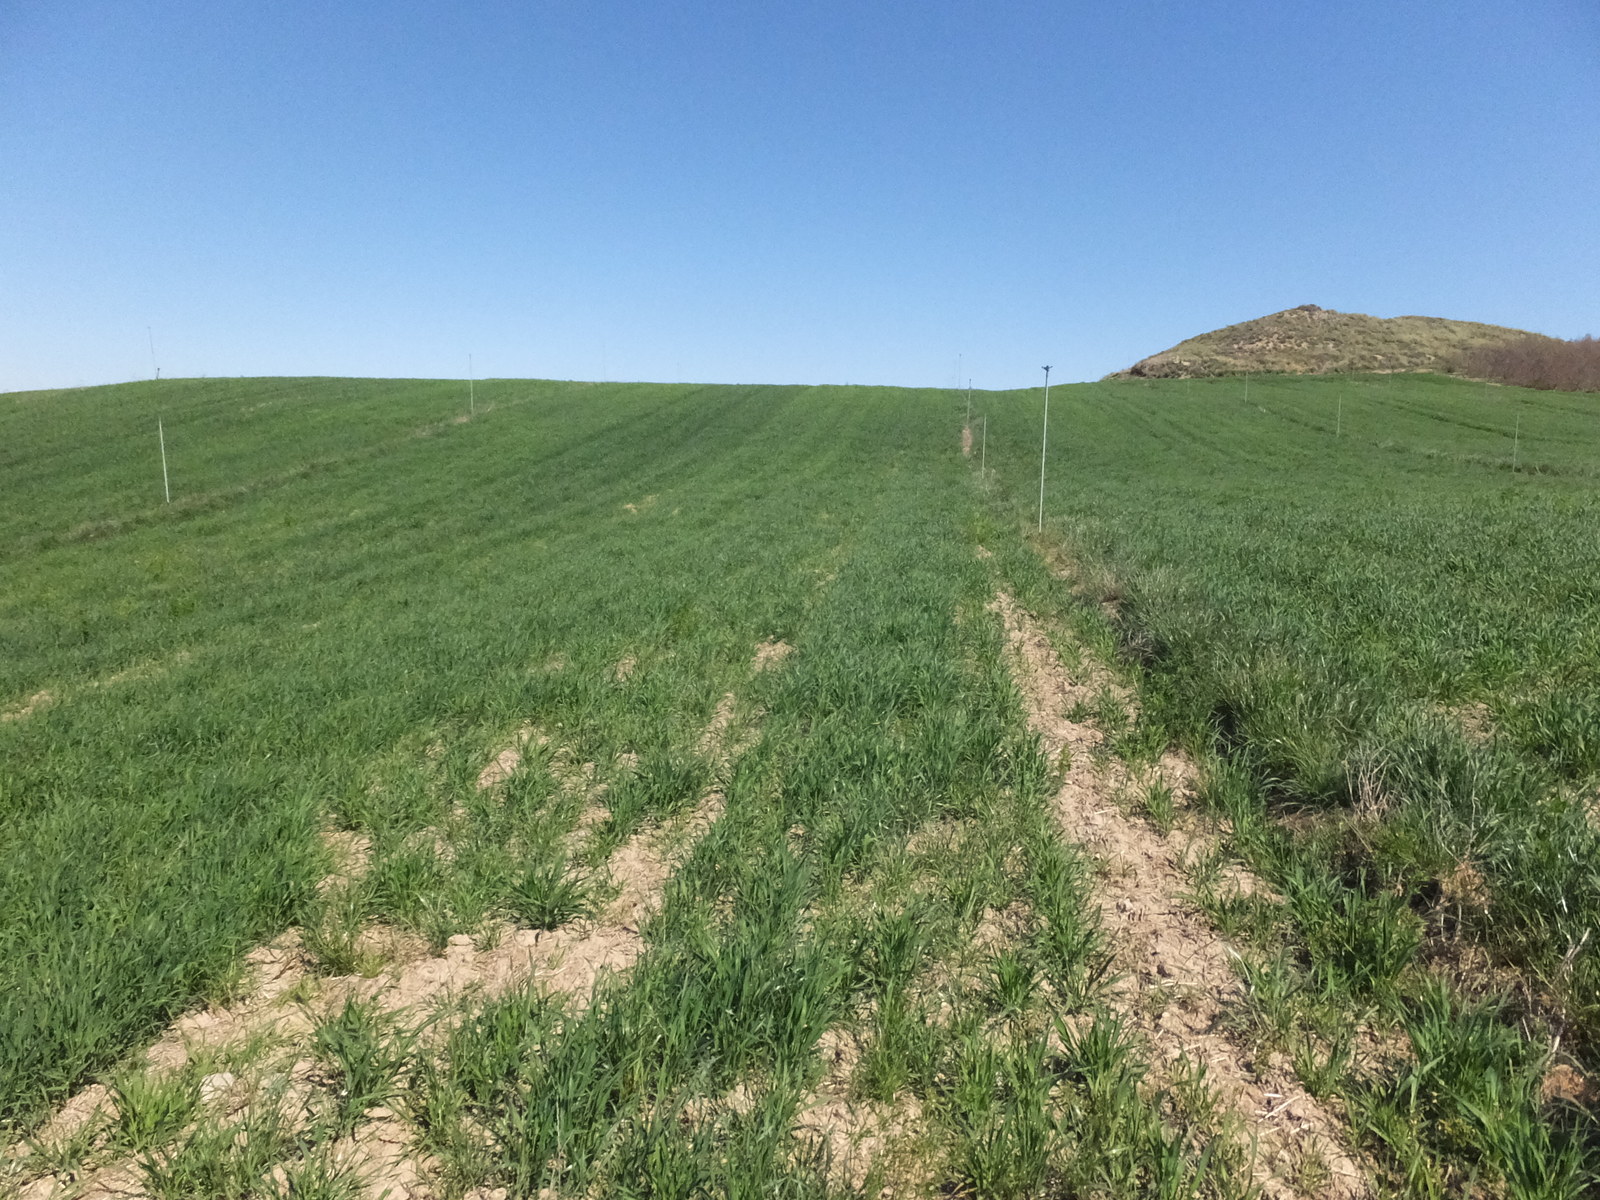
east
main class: Cropland
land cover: Durum wheat
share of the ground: > 75 %
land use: Agriculture (excluding fallow land and kitchen gardens)
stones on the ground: < 10 %
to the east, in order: Durum wheat
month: April
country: ES
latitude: 41.7122
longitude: -0.2700
